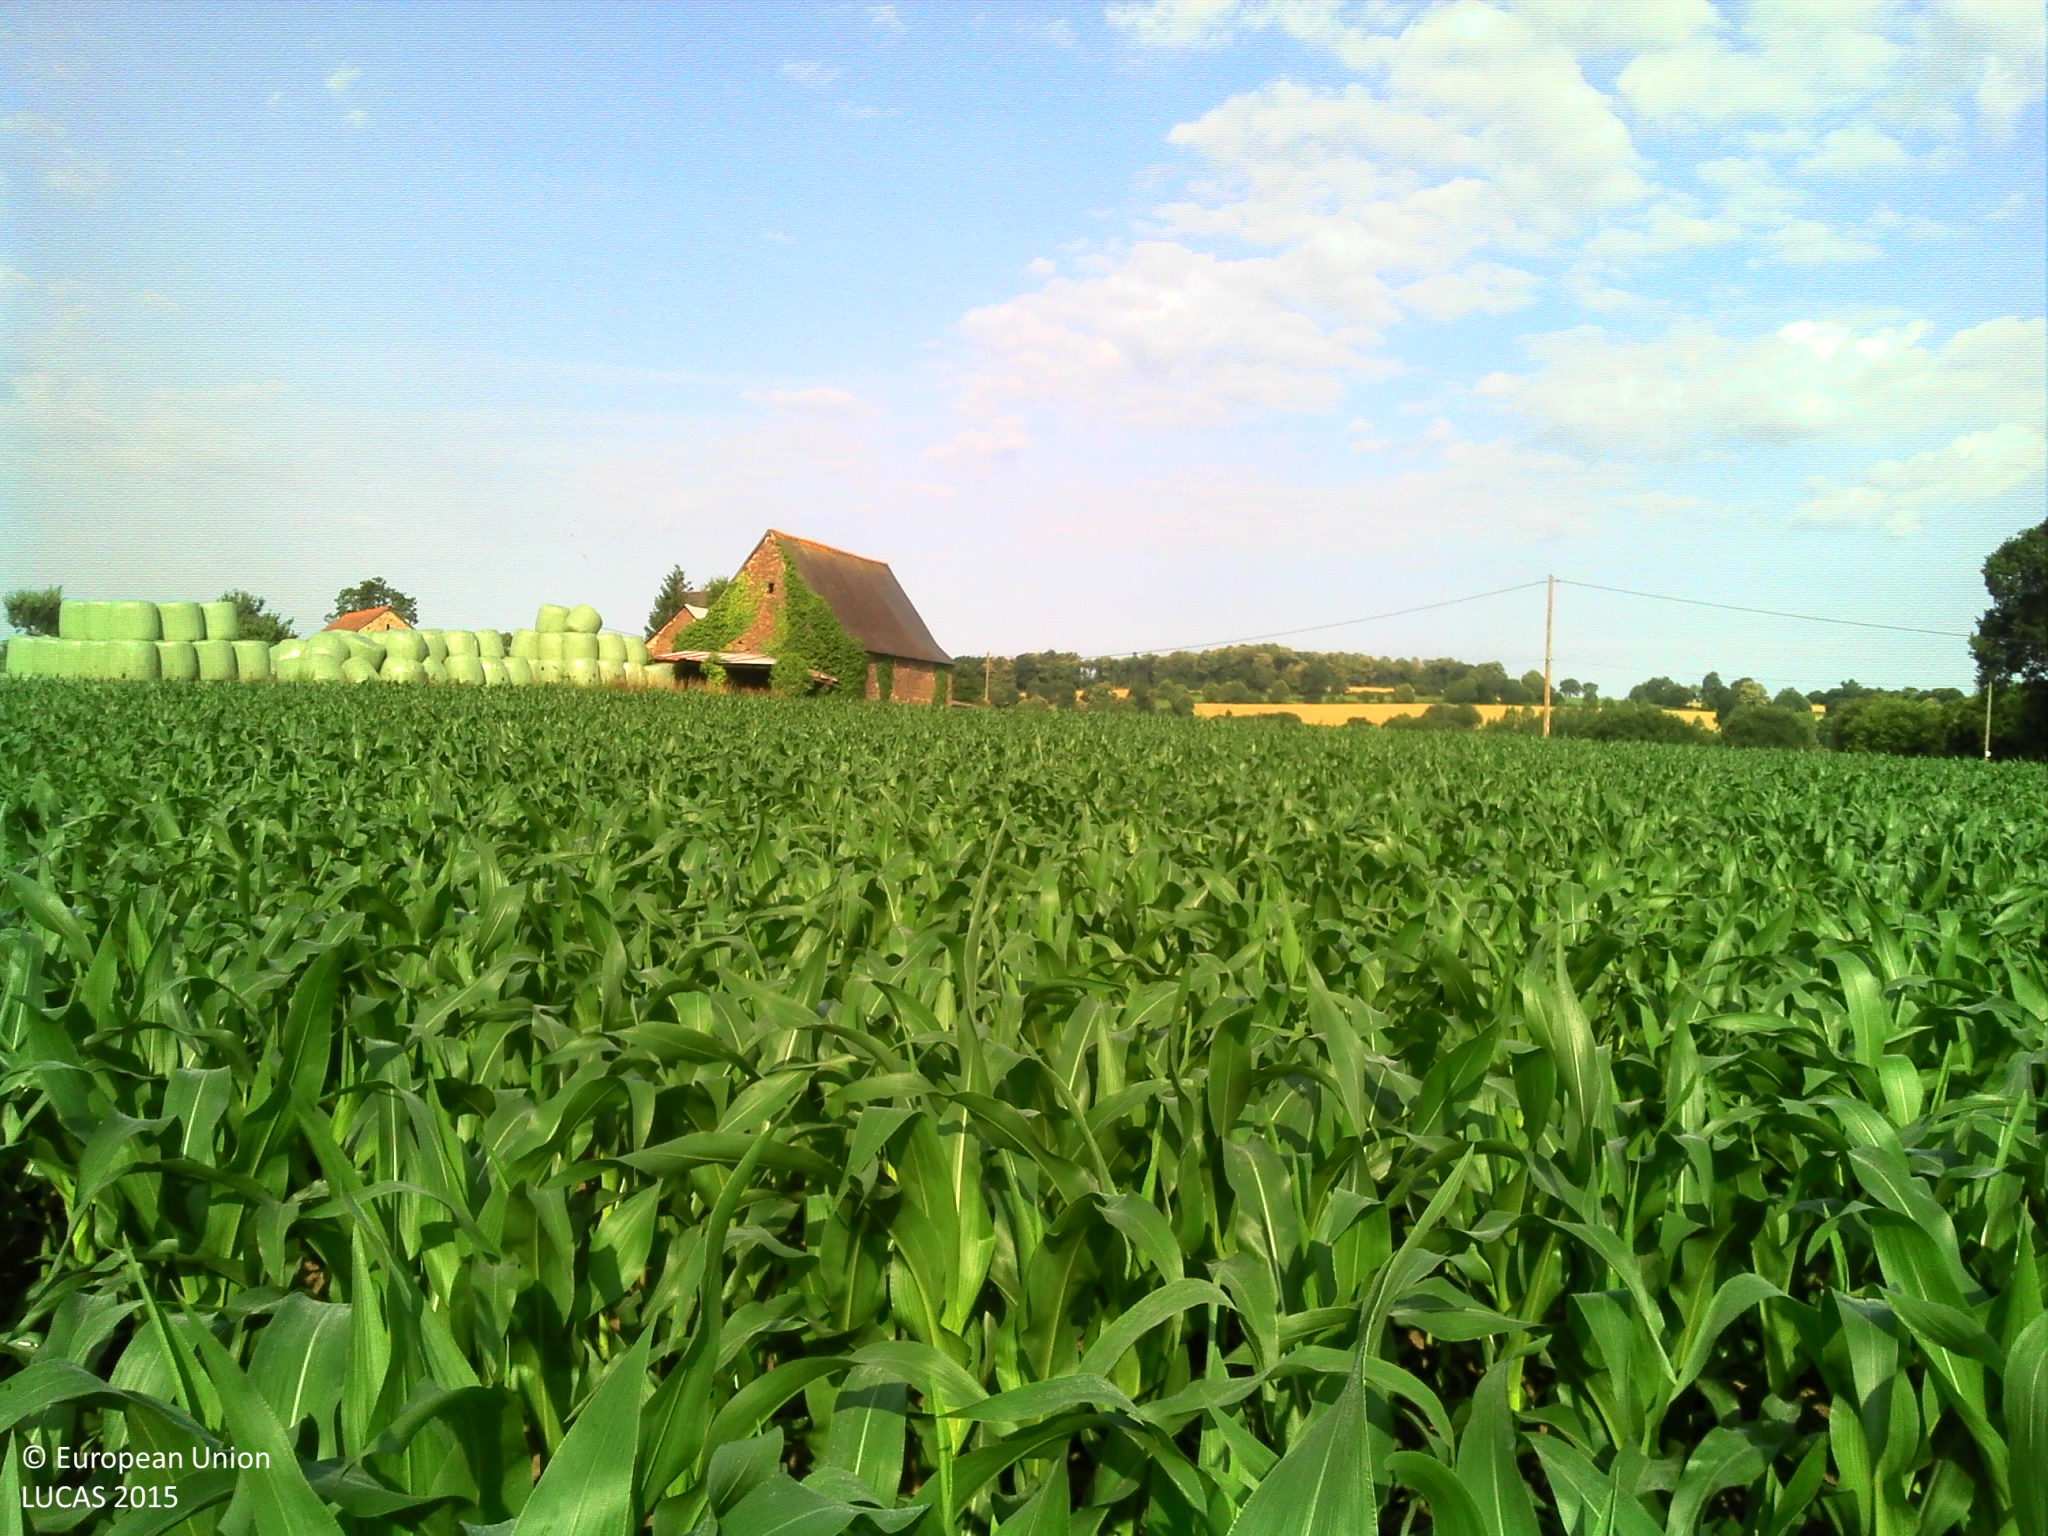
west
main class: Cropland
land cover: Maize
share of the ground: > 75 %
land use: Agriculture (excluding fallow land and kitchen gardens)
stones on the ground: < 10 %
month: July
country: FR
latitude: 48.4144
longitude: -1.5452
